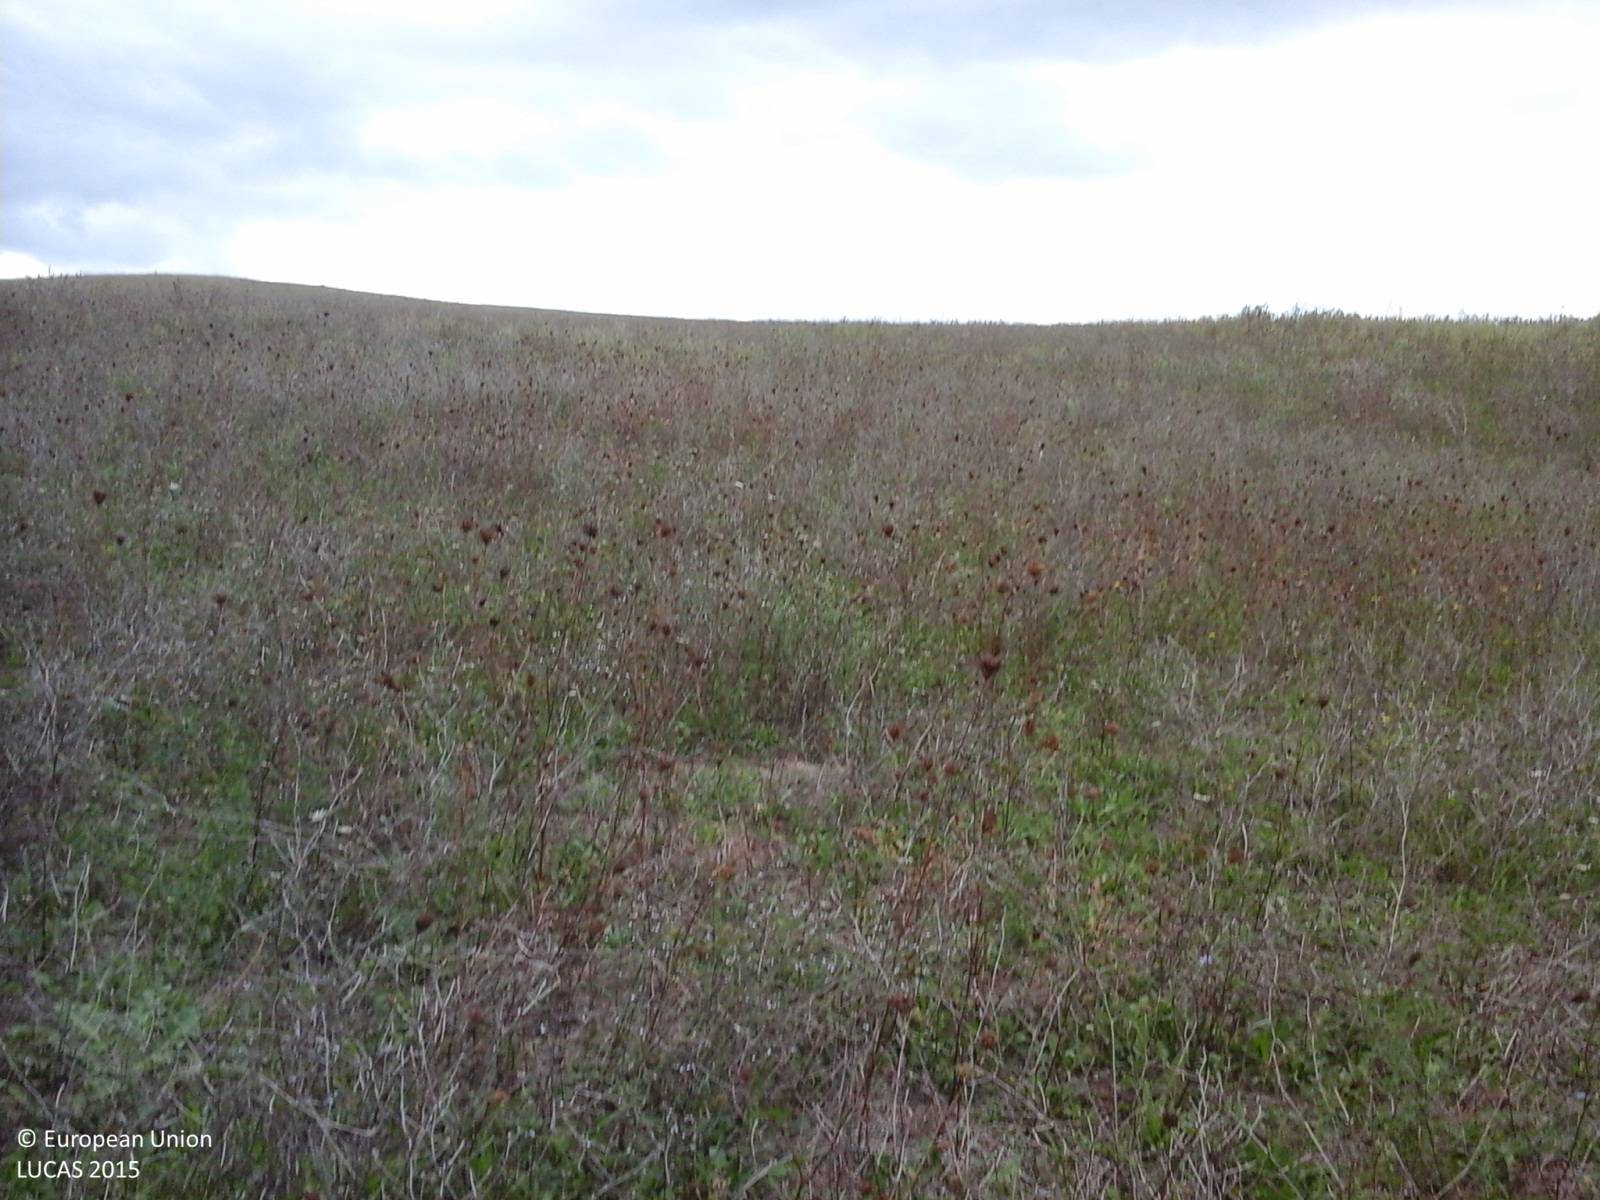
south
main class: Woodland
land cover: Broadleaved woodland
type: thermophilous deciduous forest
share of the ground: > 75 %
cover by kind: broadleaved forest trees 100 %
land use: Forestry
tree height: > 5 m
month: September
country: IT
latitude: 42.2990
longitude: 12.4539
